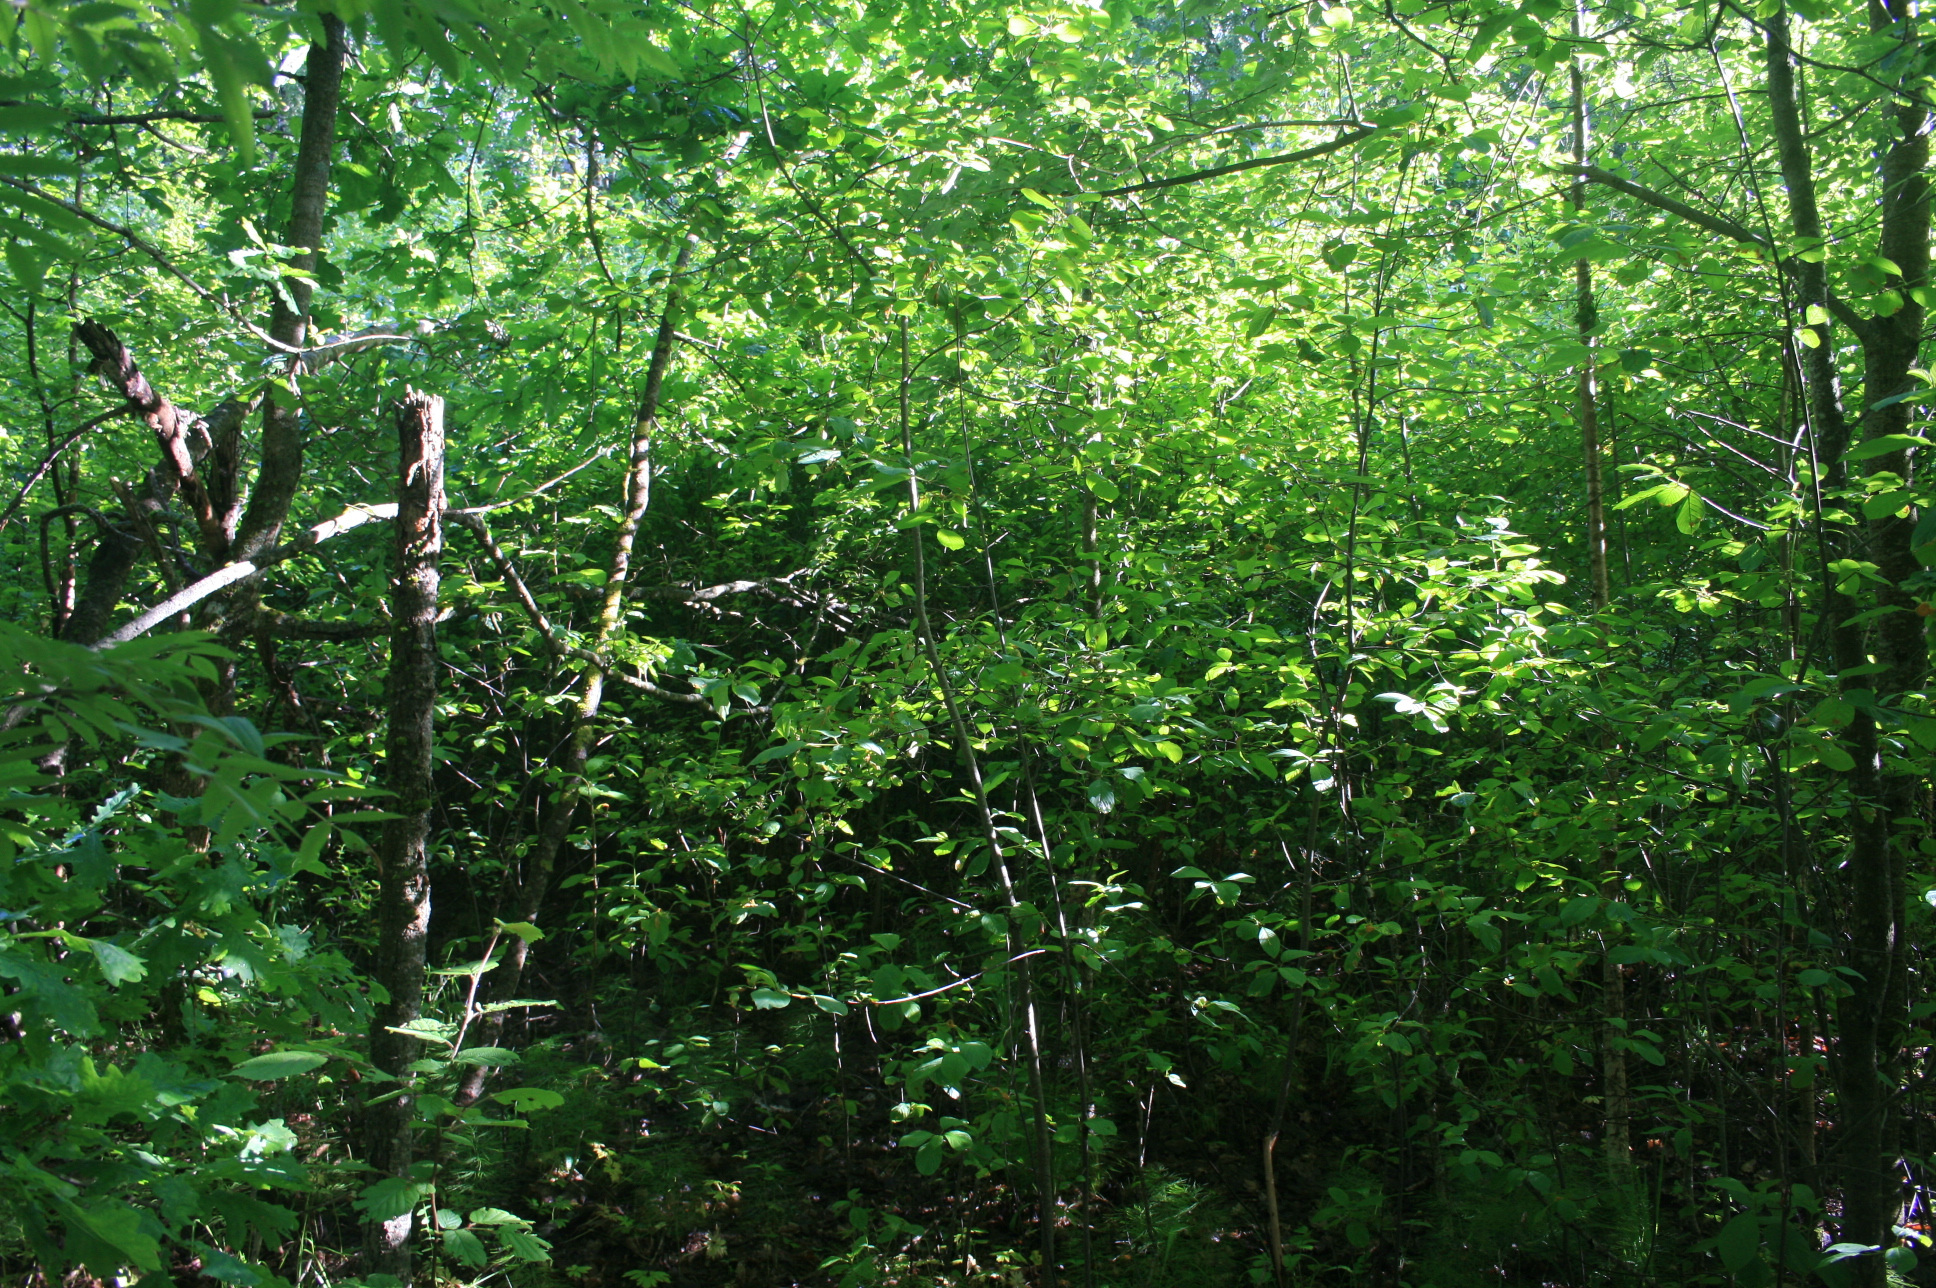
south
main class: Woodland
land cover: Broadleaved woodland
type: non-riverine alder, birch or aspen forest
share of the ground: > 75 %
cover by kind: broadleaved forest trees 95 %, herbaceous plants 5 %
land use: Forestry
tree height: > 5 m
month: June
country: LT
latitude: 55.5031
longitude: 22.1028
